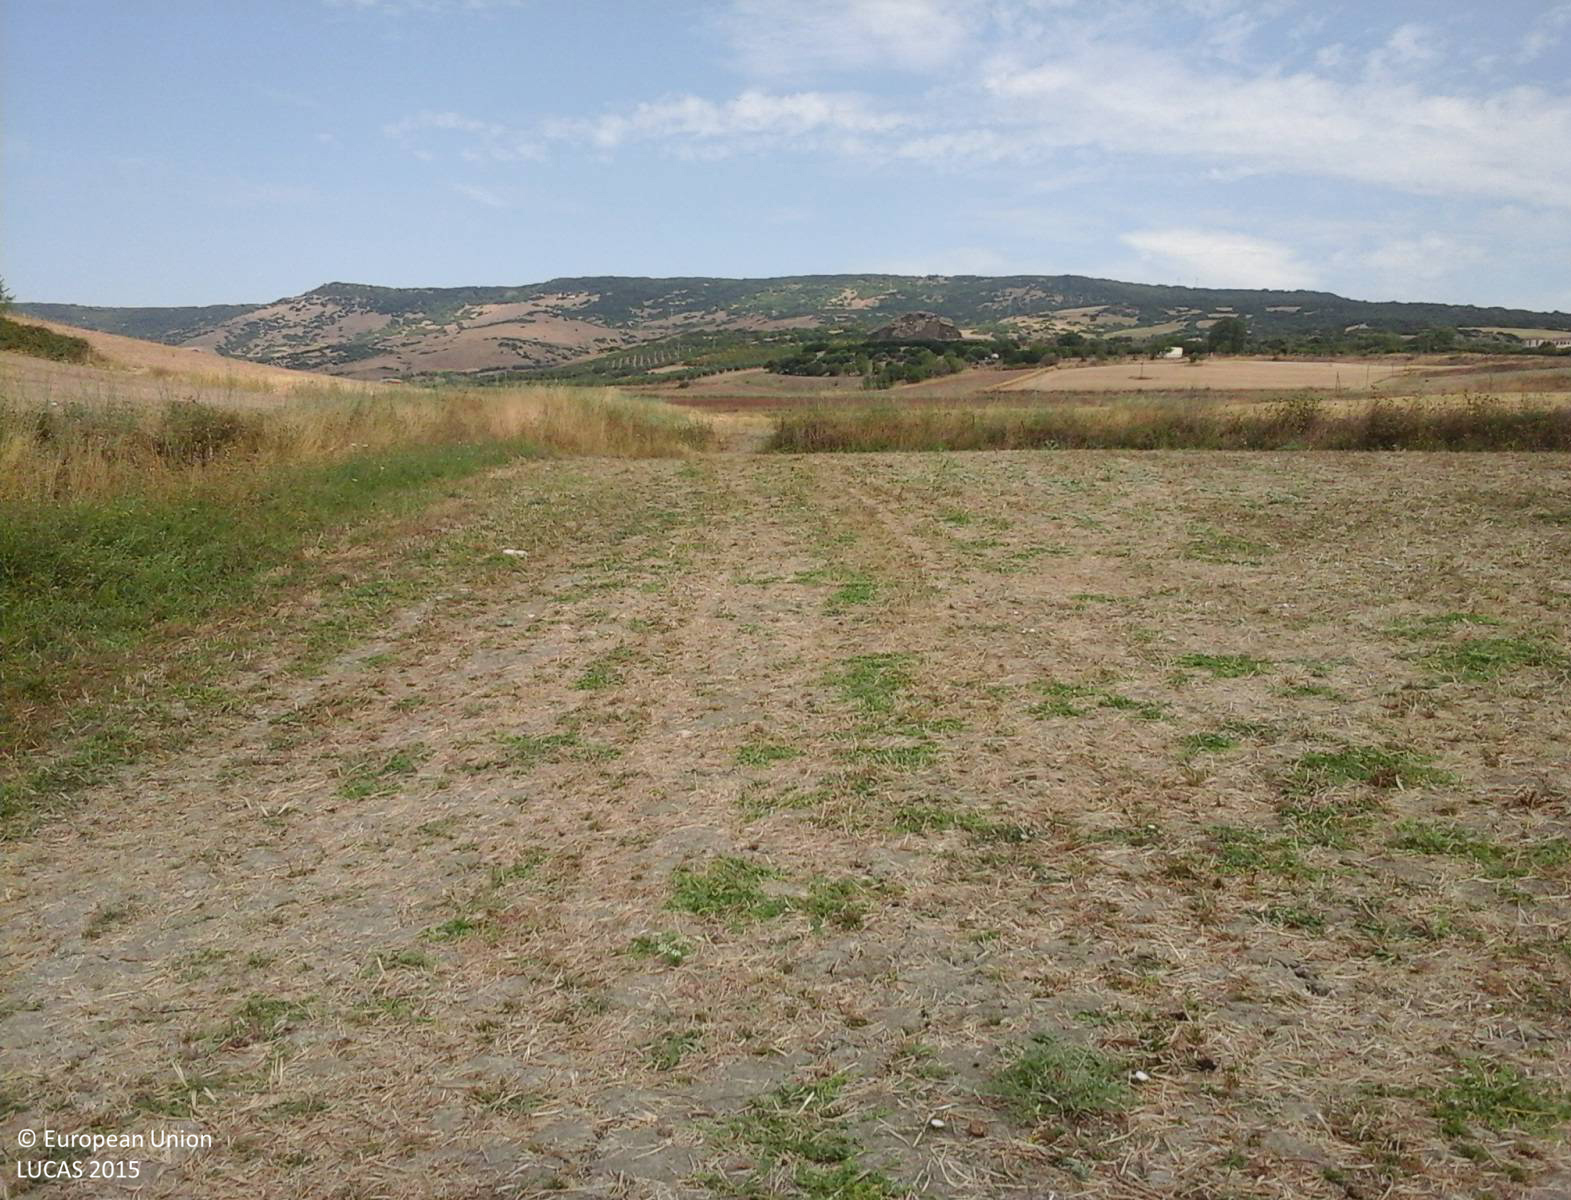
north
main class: Cropland
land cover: Temporary grasslands
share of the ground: > 75 %
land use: Agriculture (excluding fallow land and kitchen gardens)
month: July
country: IT
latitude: 39.7008
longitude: 8.9912
